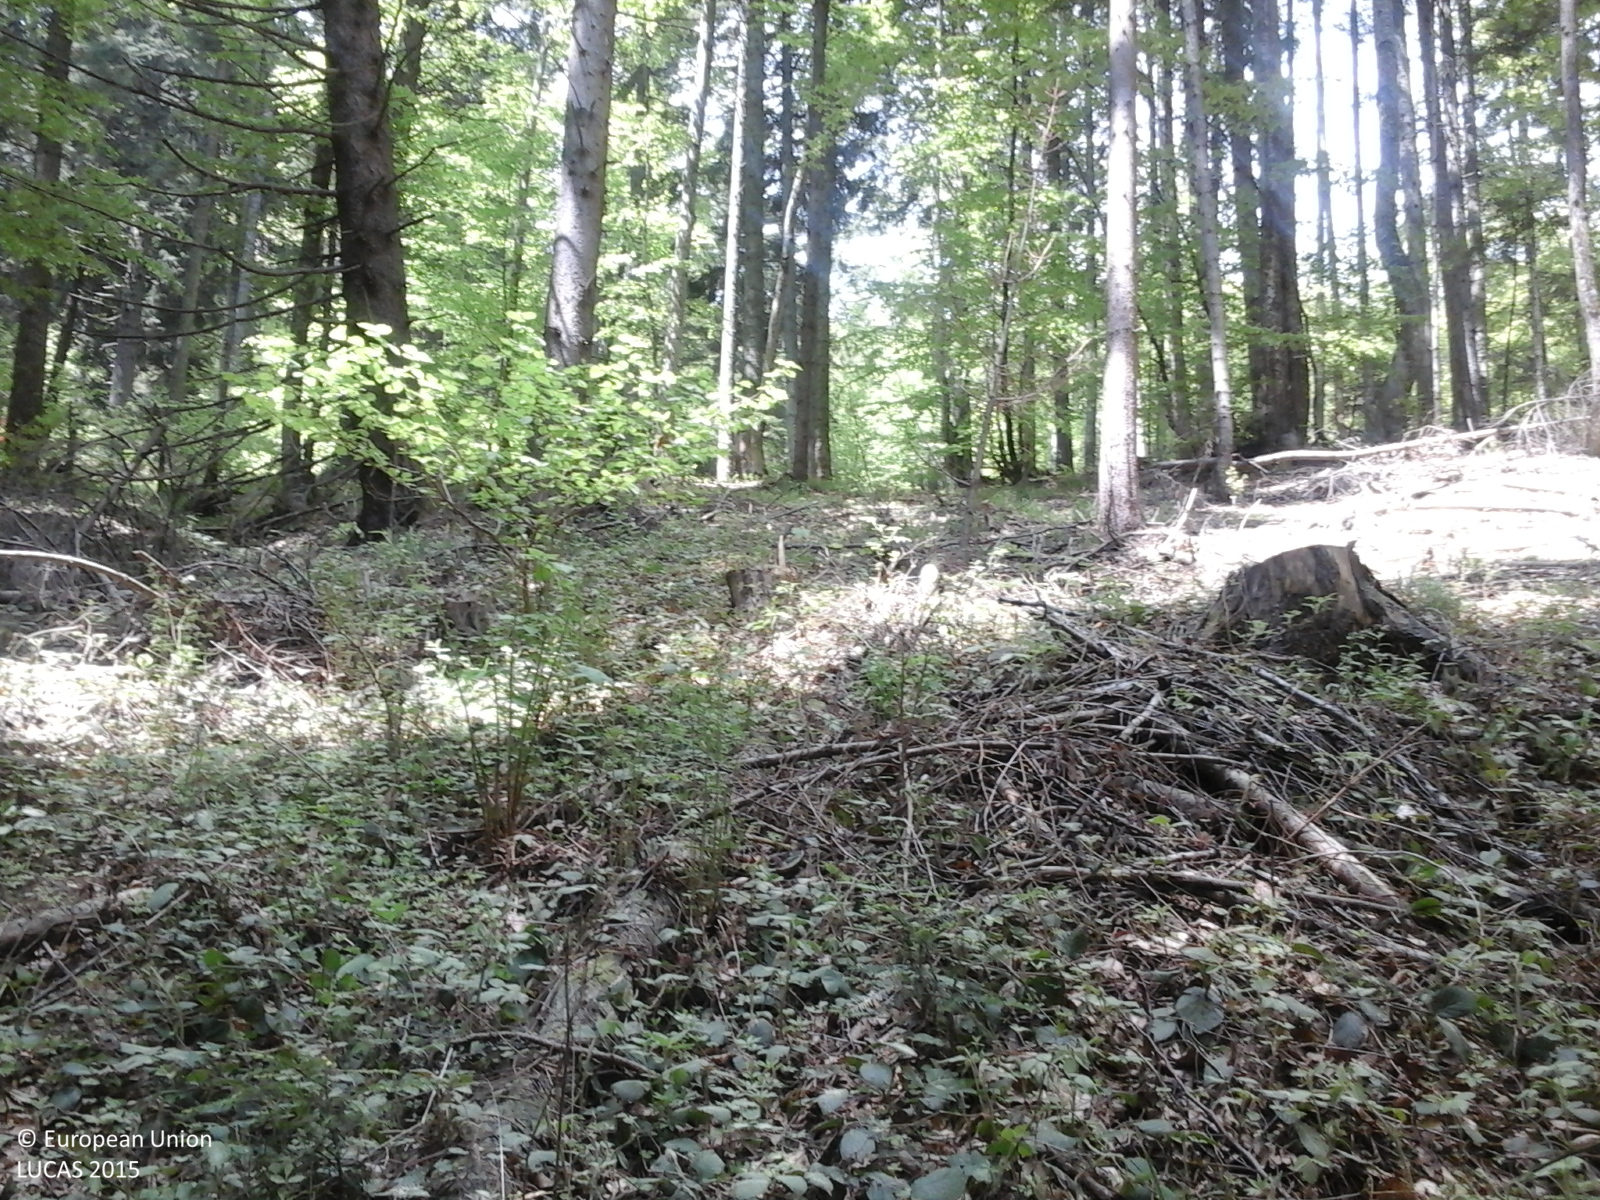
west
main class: Woodland
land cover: Spruce dominated mixed woodland
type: alpine coniferous forest
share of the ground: > 75 %
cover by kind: coniferous forest trees 75 %, broadleaved forest trees 25 %
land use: Forestry
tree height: > 5 m
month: May
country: RO
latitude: 45.9857
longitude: 26.3262
